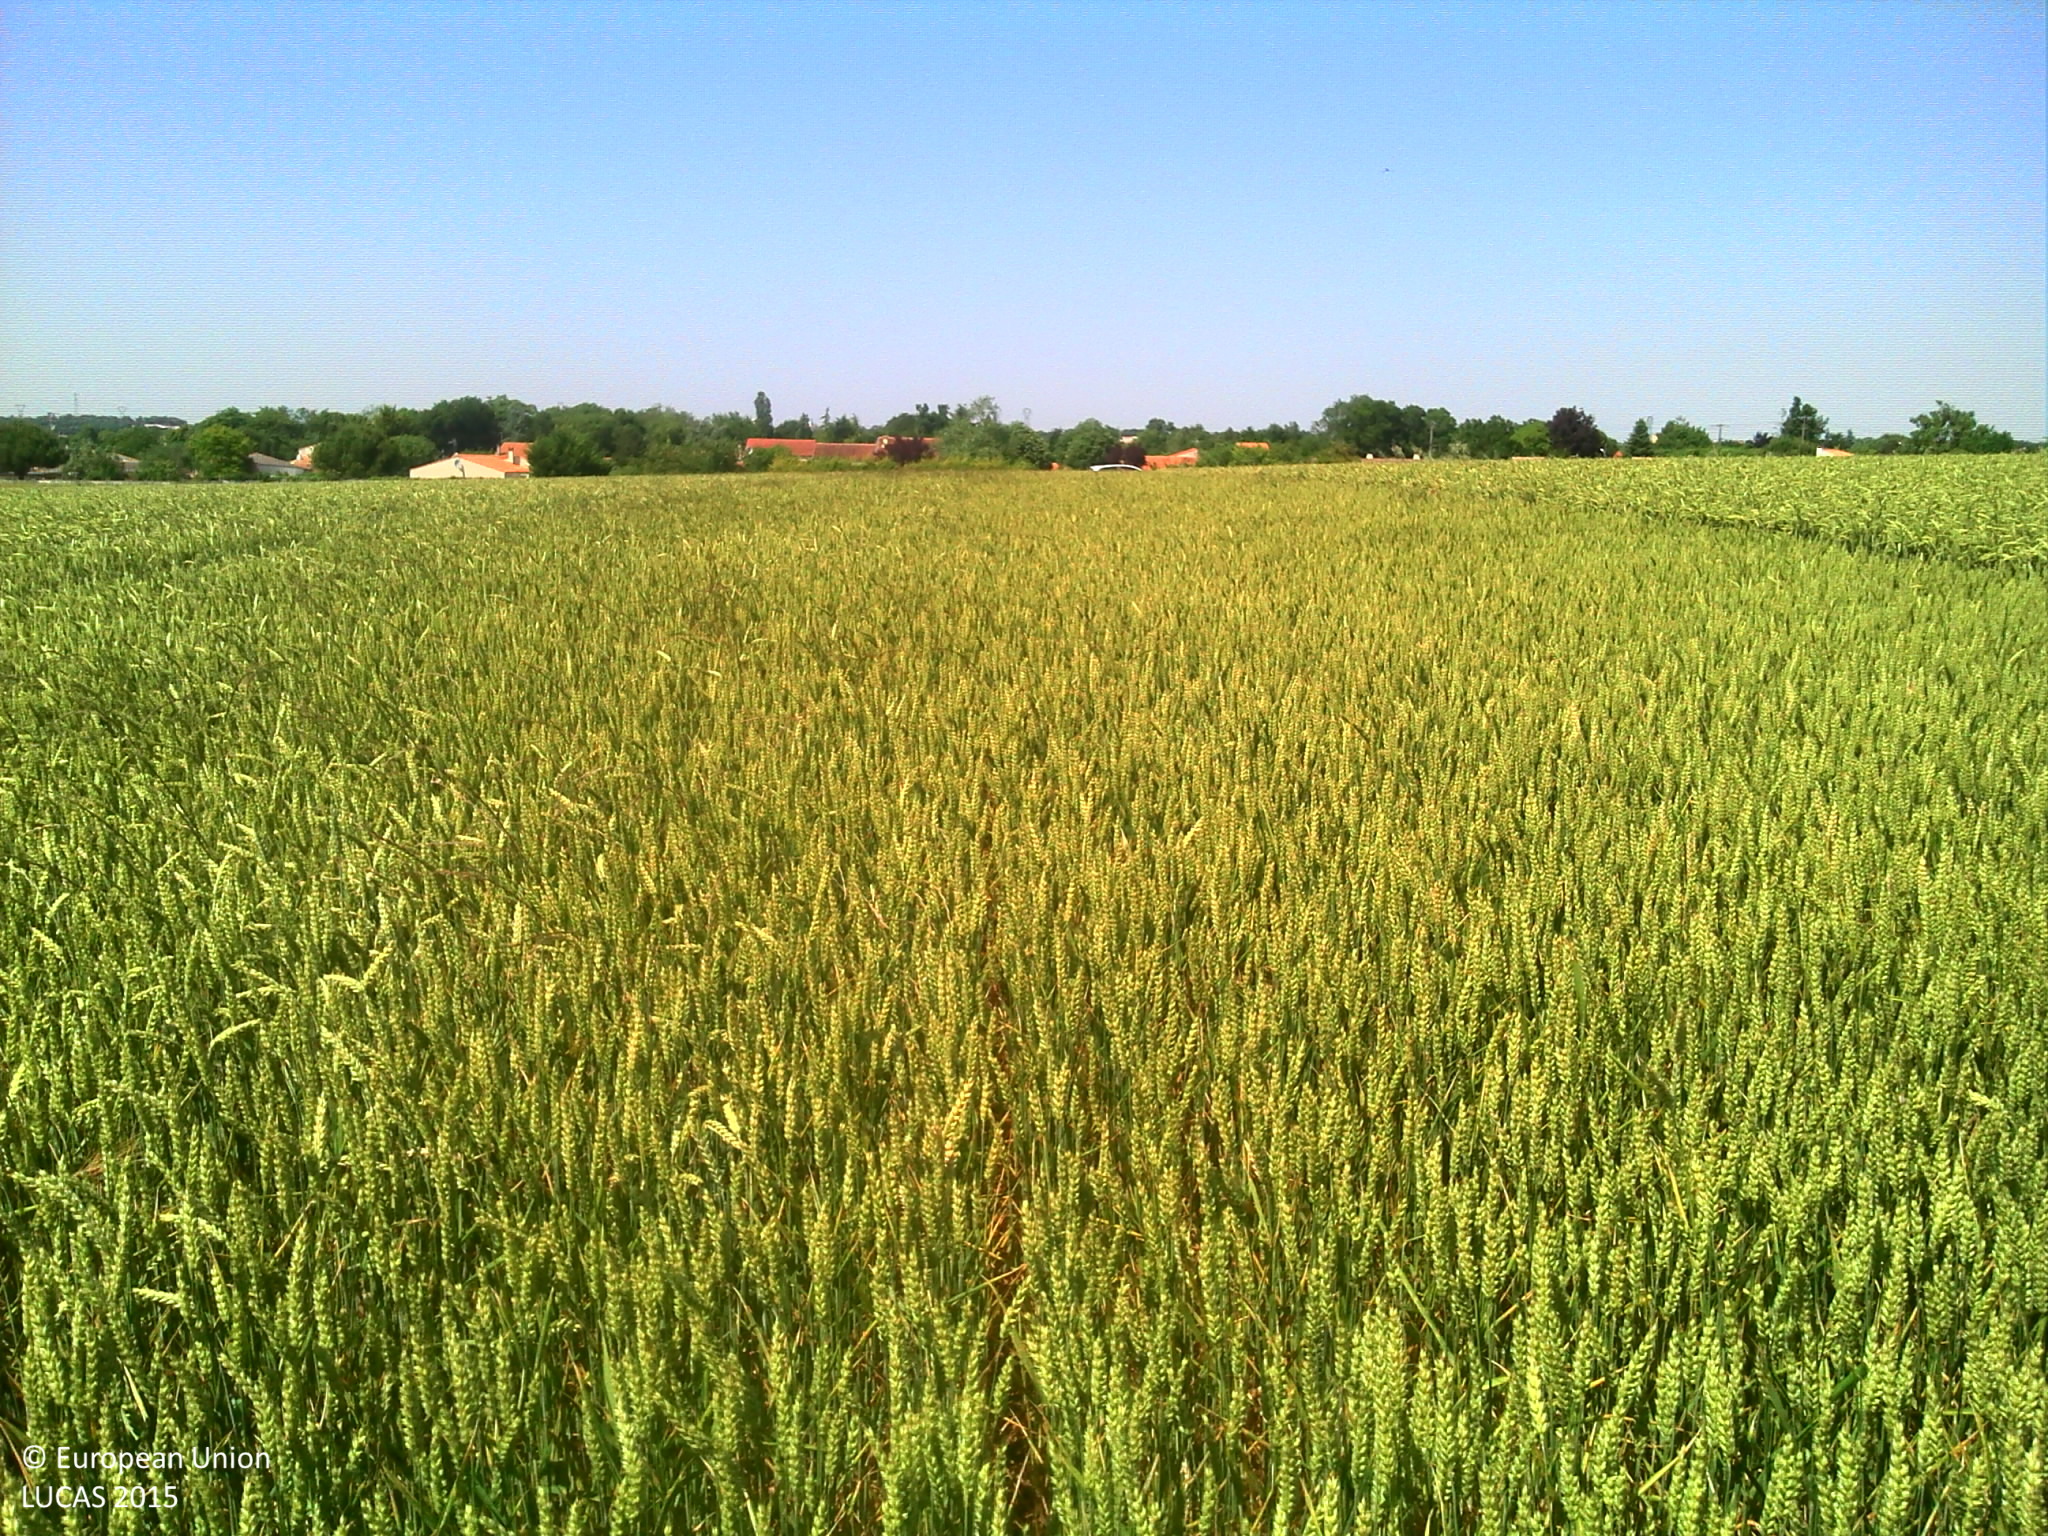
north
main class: Cropland
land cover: Common wheat
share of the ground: > 75 %
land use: Agriculture (excluding fallow land and kitchen gardens)
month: June
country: FR
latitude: 46.1077
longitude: -1.0140
